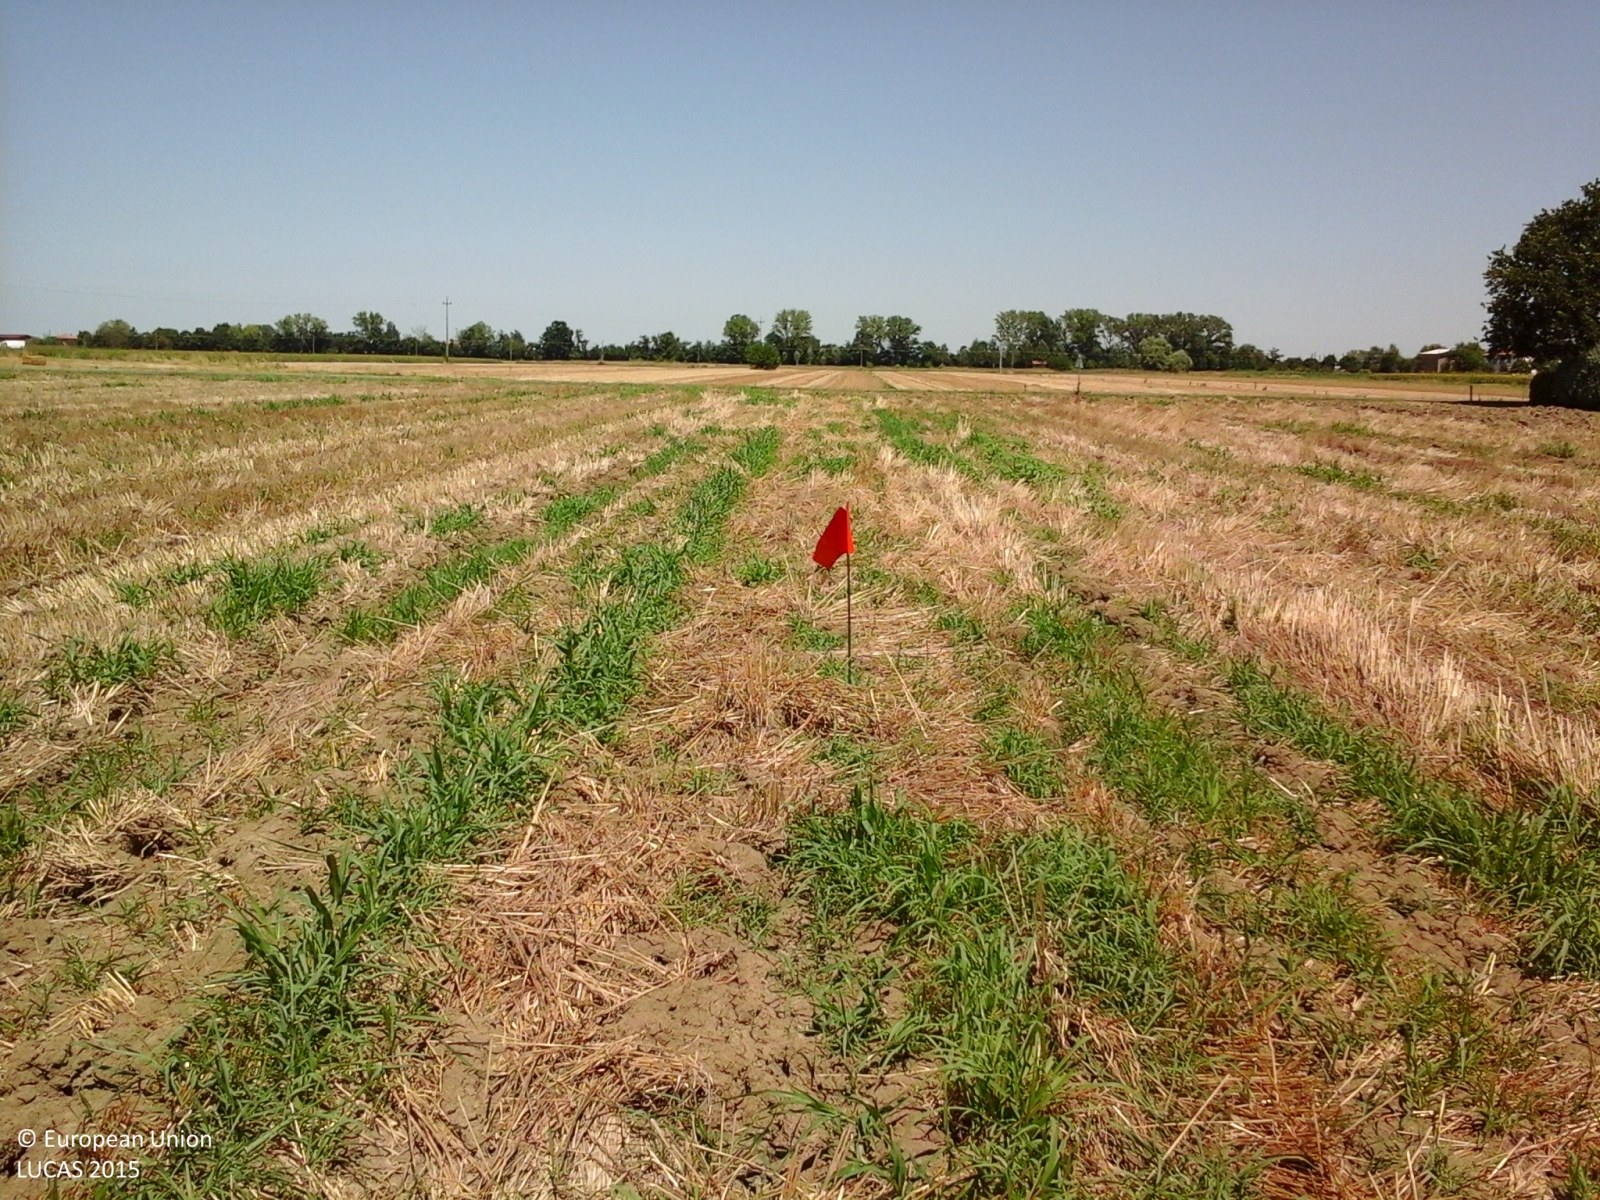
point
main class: Cropland
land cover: Common wheat
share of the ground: > 75 %
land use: Agriculture (excluding fallow land and kitchen gardens)
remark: Harvested field
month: July
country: IT
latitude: 44.4462
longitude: 11.6174
